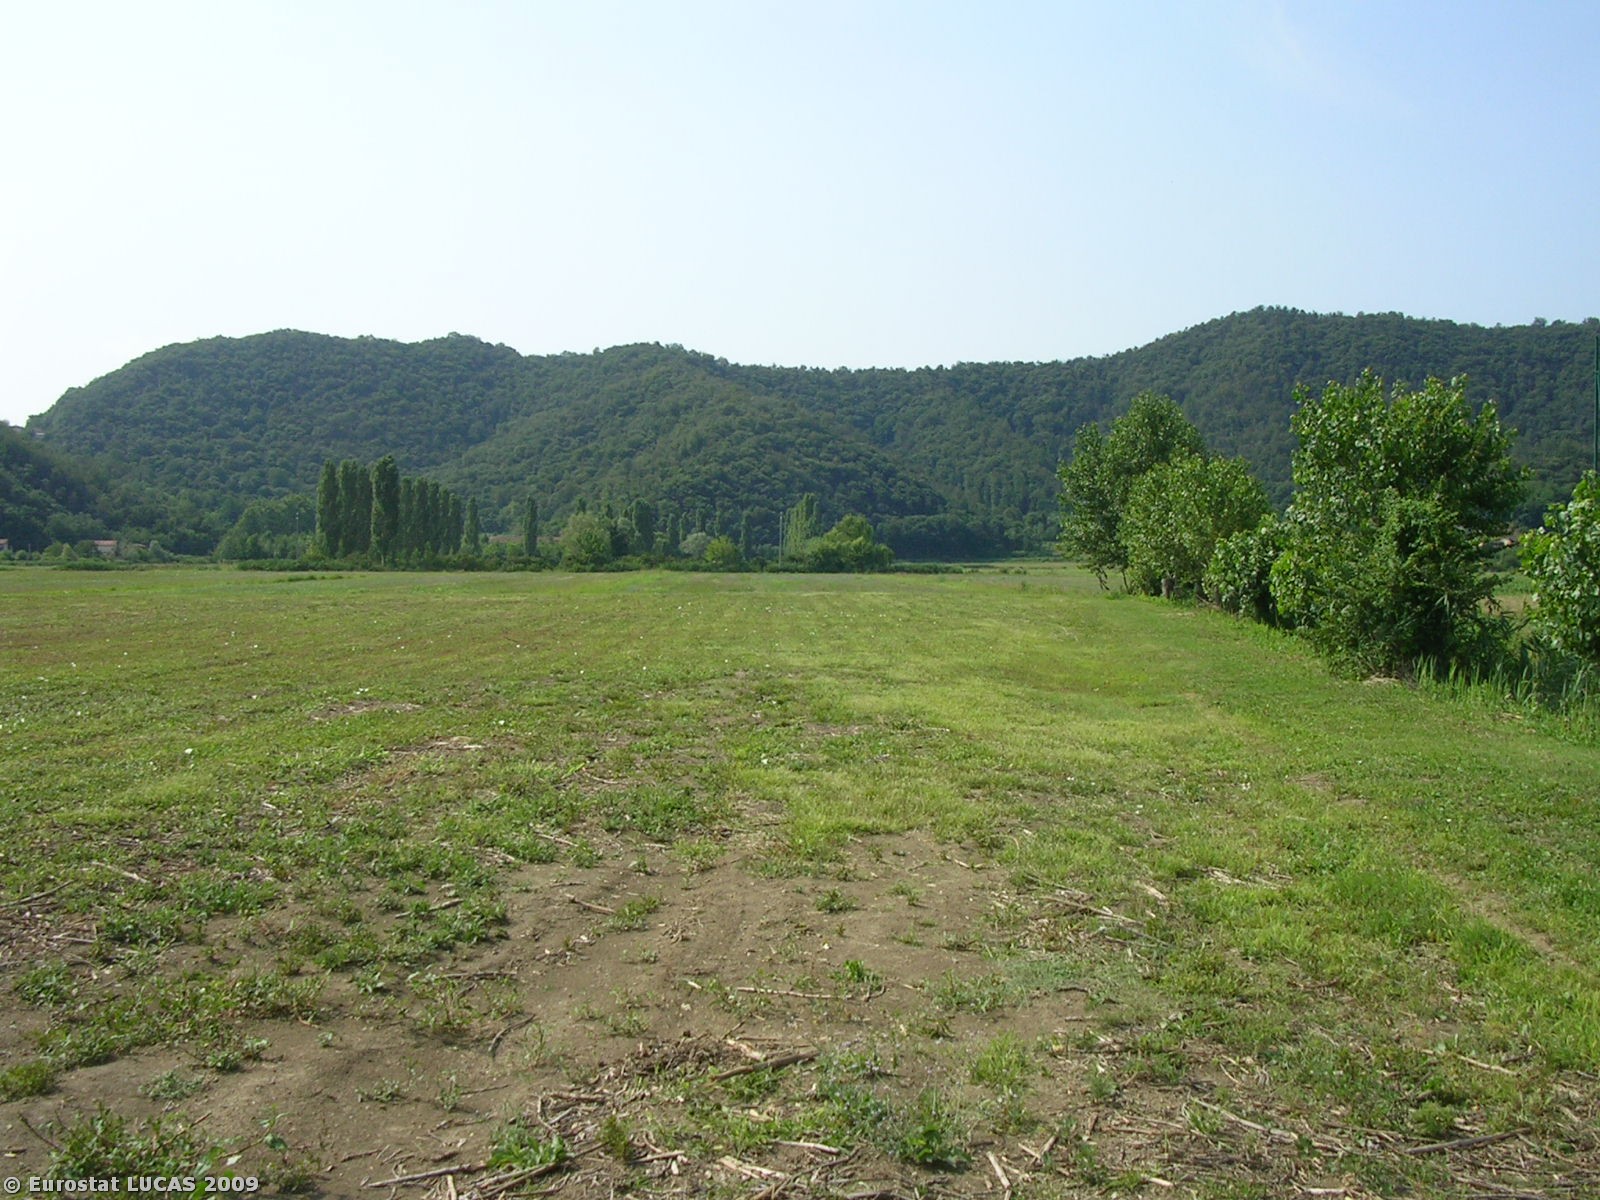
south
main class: Grassland
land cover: Grassland without tree/shrub cover
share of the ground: > 75 %
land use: Fallow land
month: July
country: IT
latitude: 45.3278
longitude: 11.7450
